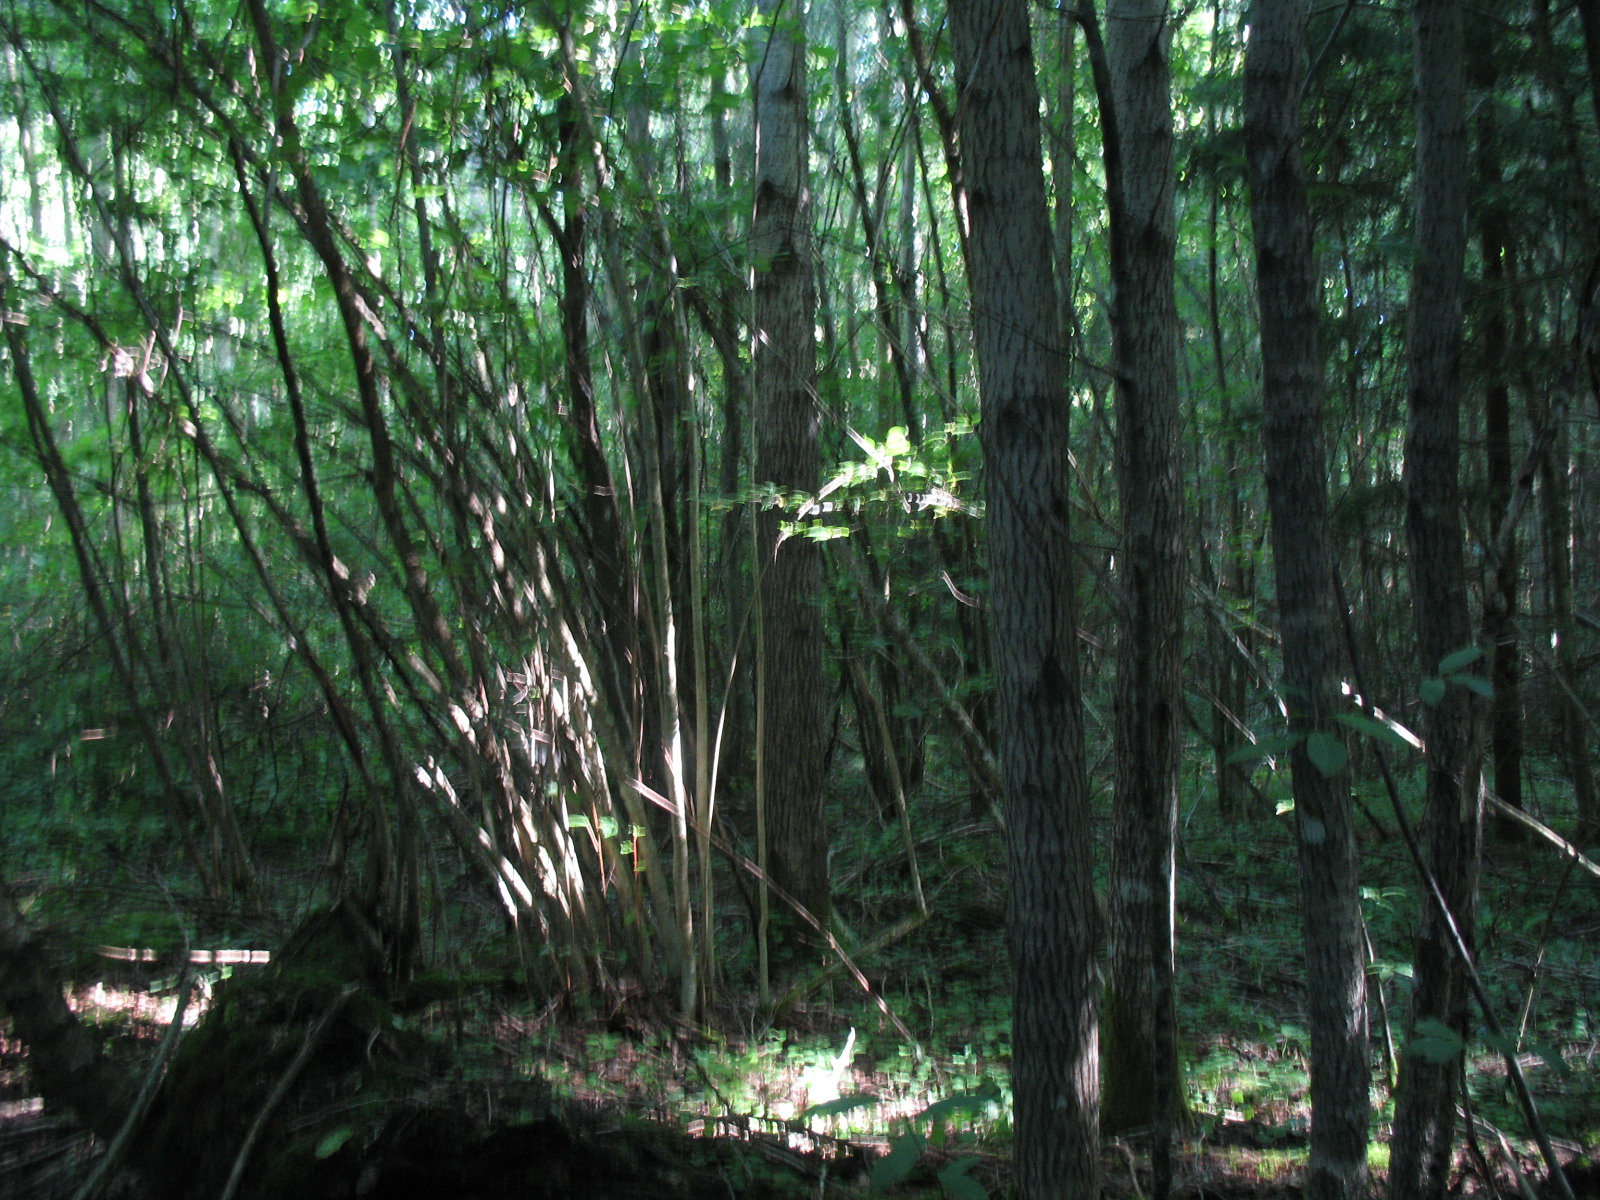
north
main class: Woodland
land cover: Broadleaved woodland
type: non-riverine alder, birch or aspen forest
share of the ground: > 75 %
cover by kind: broadleaved forest trees 90 %, shrubs 5 %, herbaceous plants 5 %
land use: Forestry
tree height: > 5 m
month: July
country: LV
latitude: 56.2224
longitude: 25.0937
